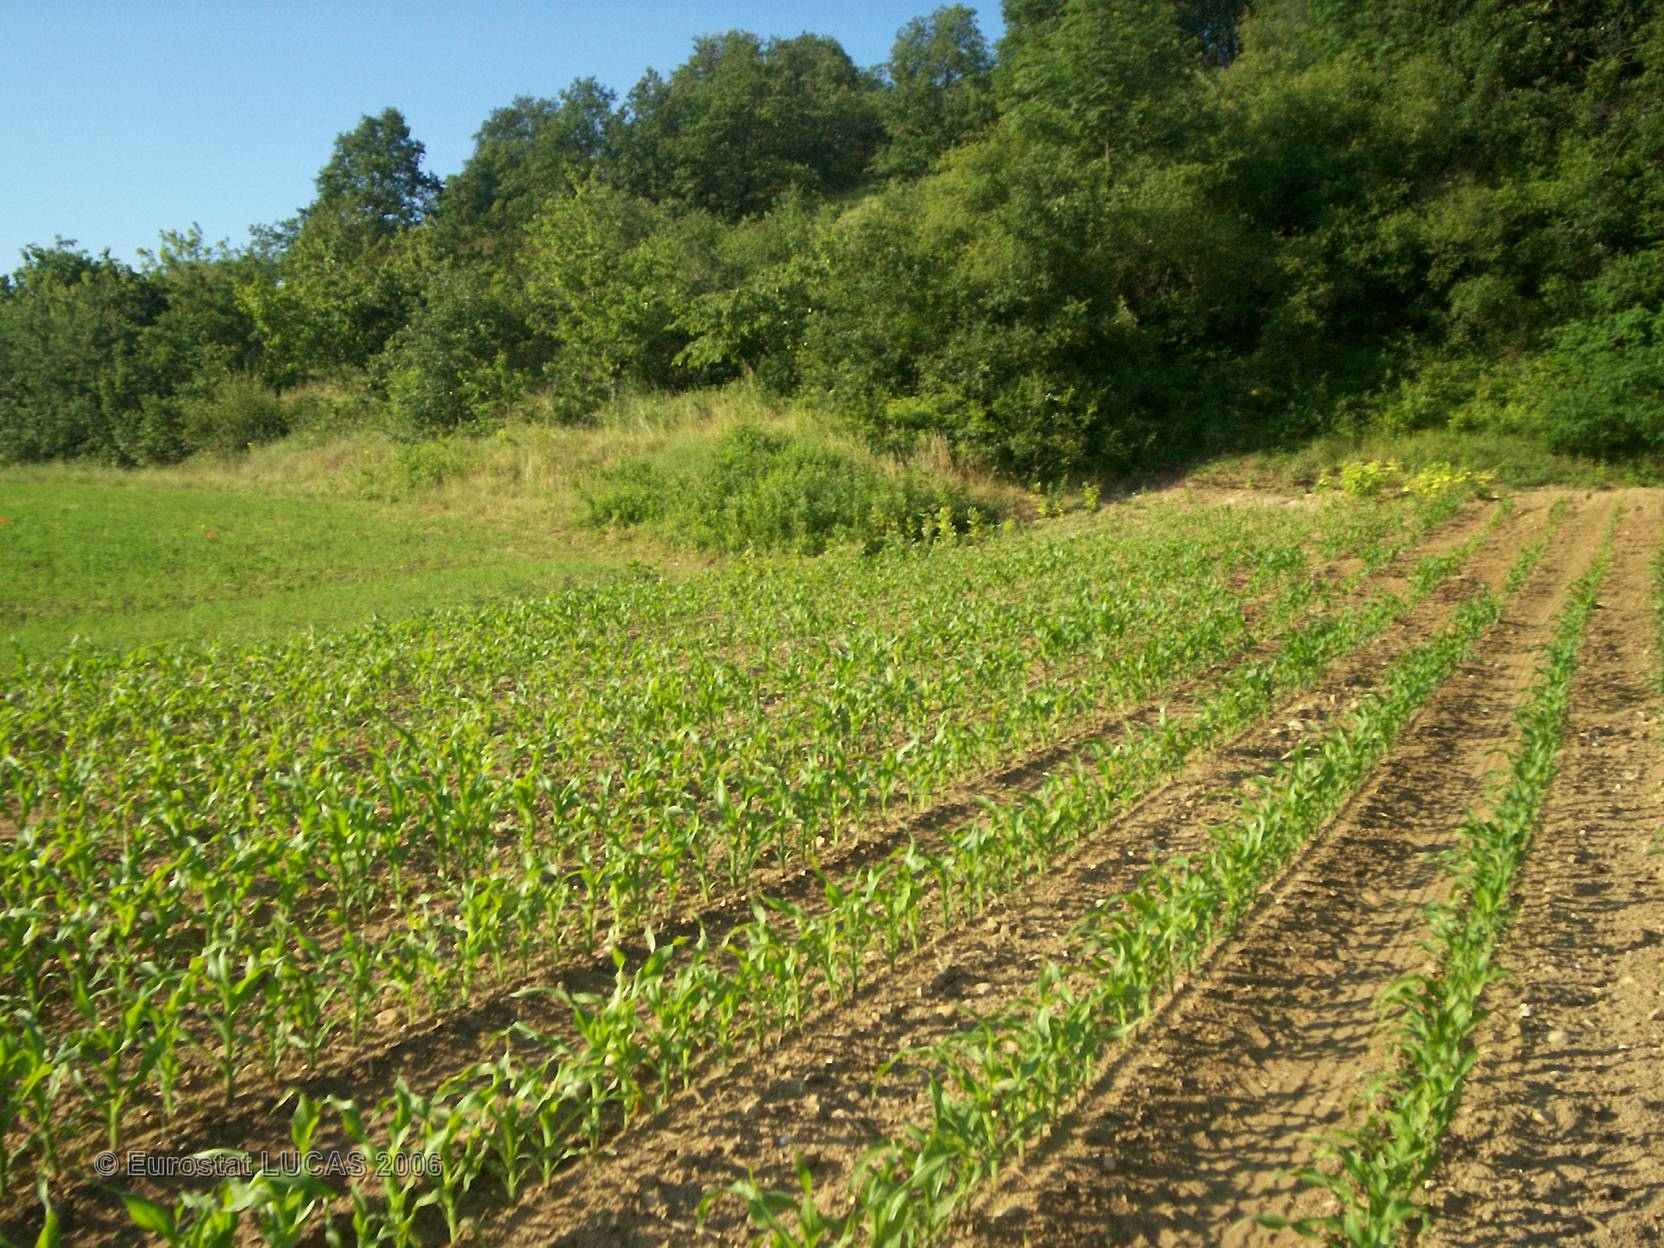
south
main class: Cropland
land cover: Maize
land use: Agriculture (excluding fallow land and kitchen gardens)
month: June
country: FR
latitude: 45.2149
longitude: 4.8224
